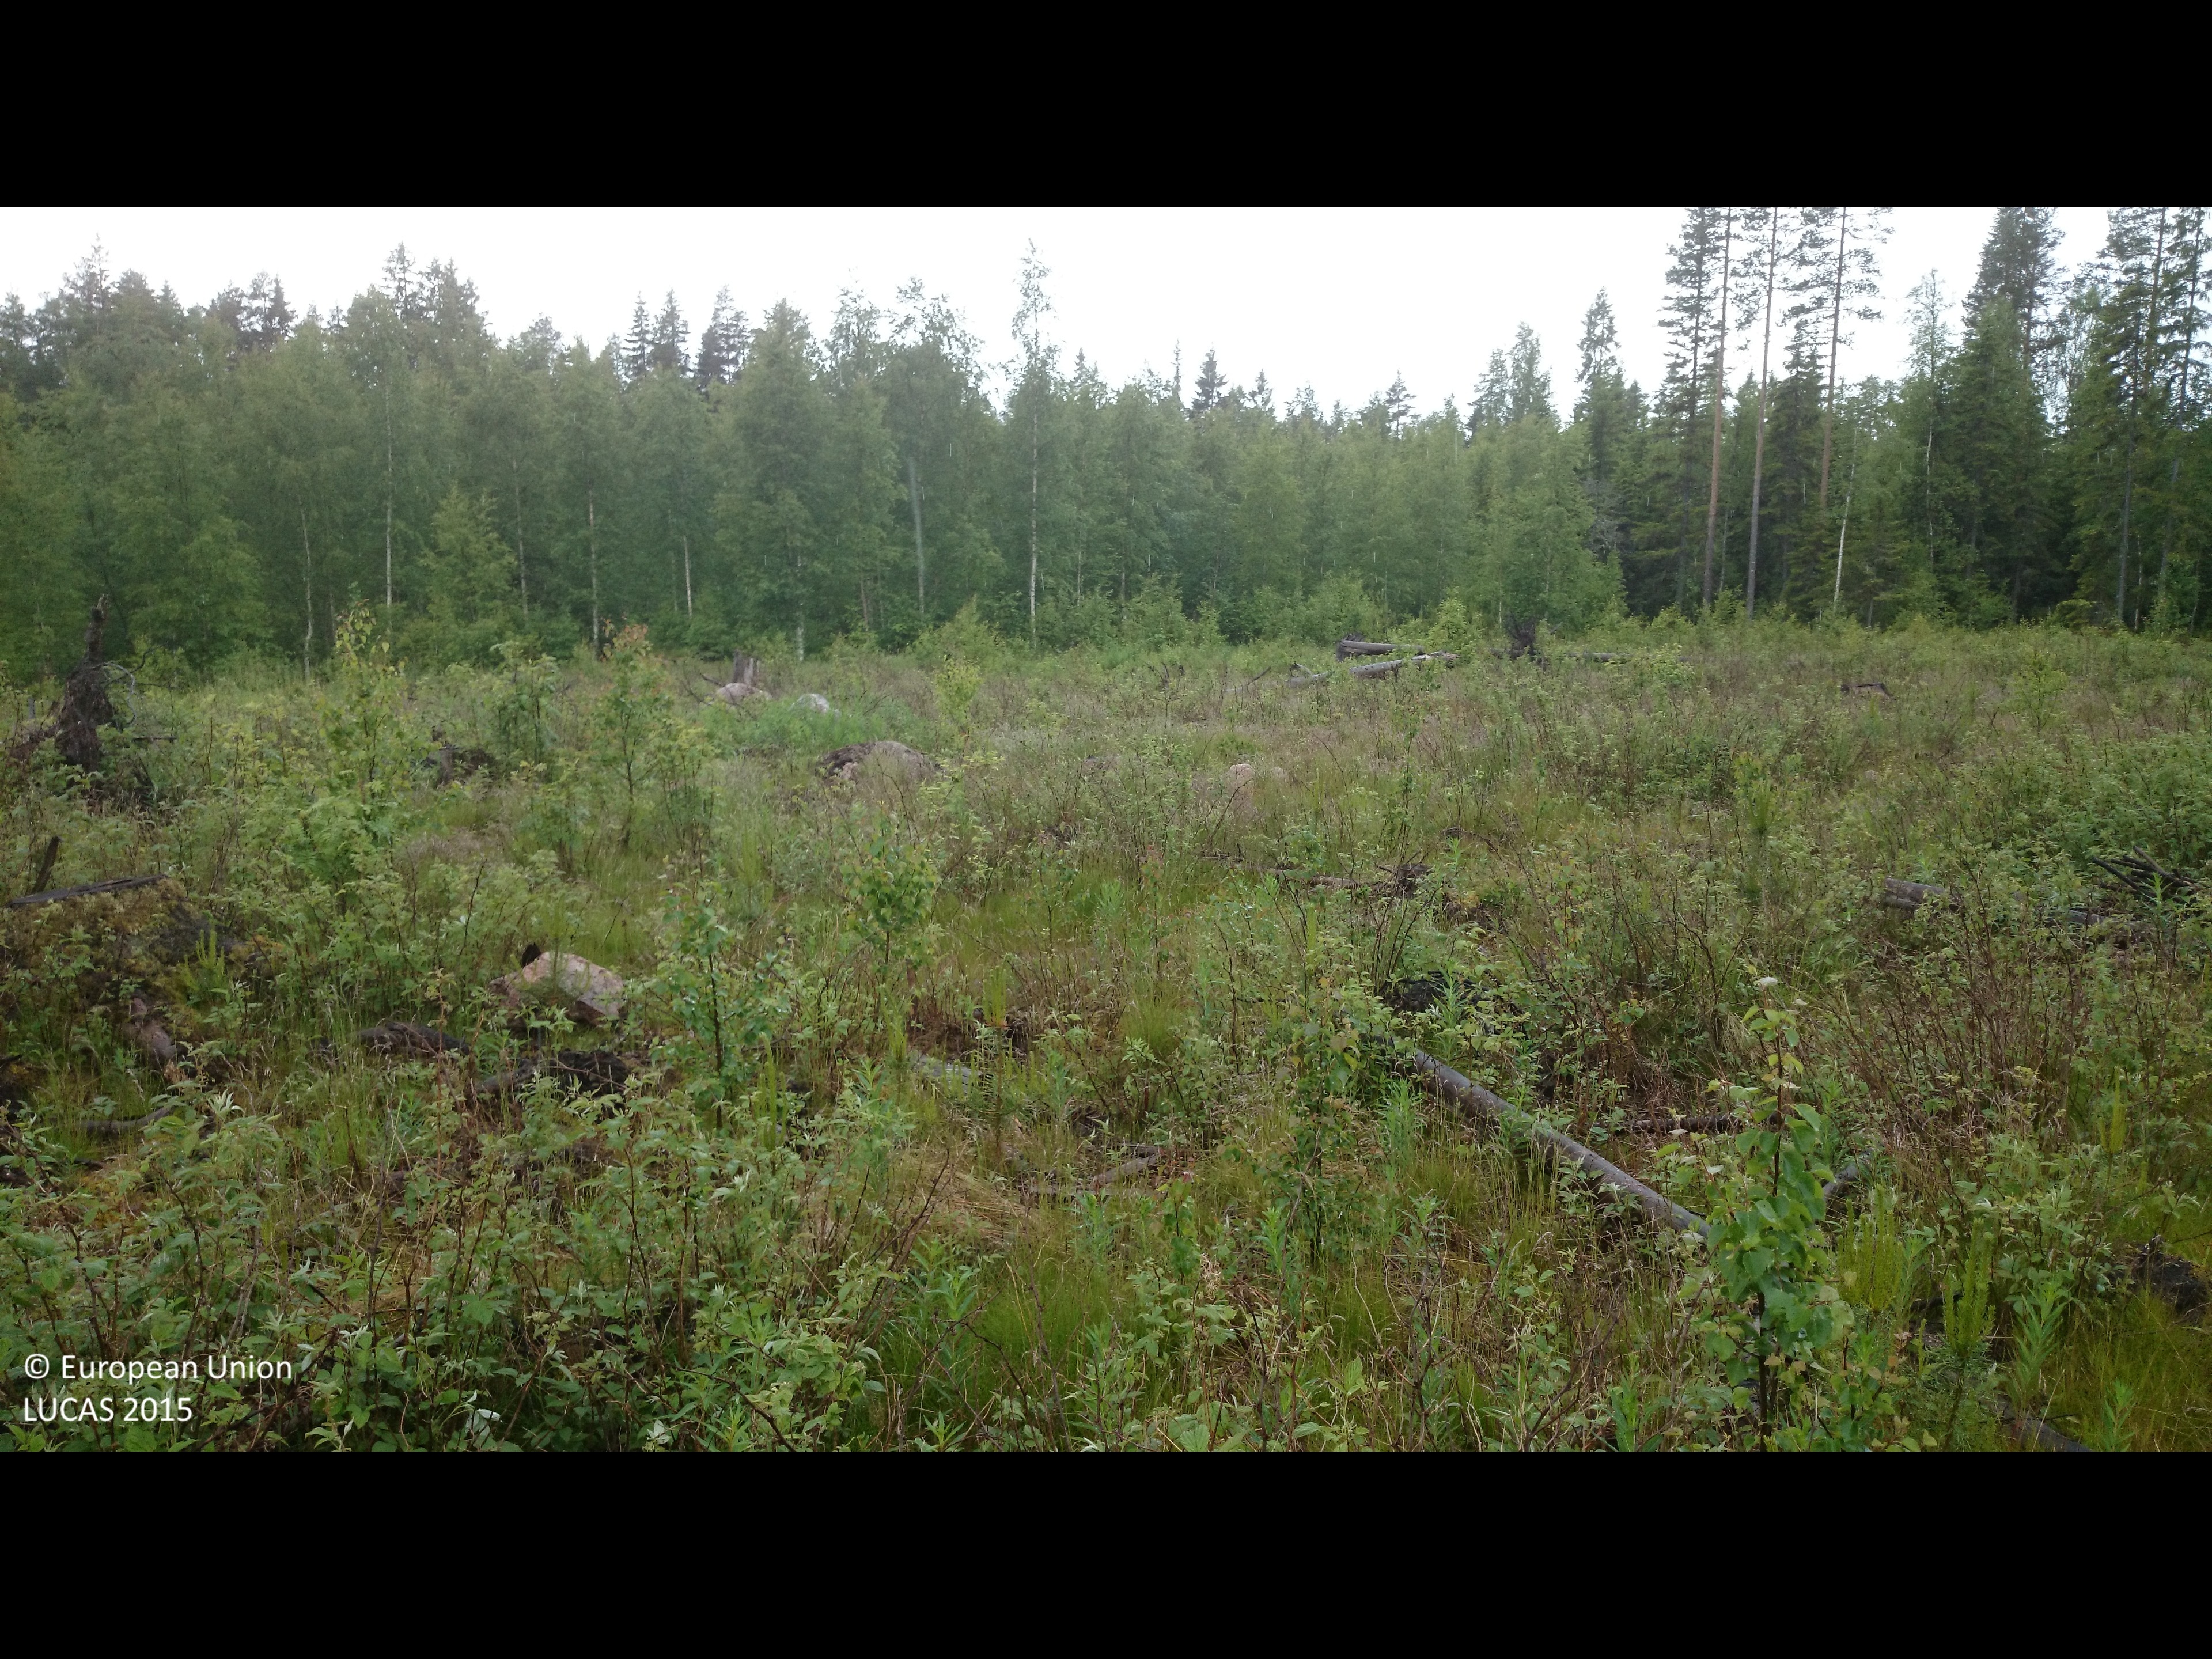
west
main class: Shrubland
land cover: Shrubland with sparse tree cover
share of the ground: 25 - 50 %
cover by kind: herbaceous plants 40 %, shrubs 30 %, lichens and mosses 25 %, coniferous forest trees 5 %
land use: Forestry
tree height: < 5 m
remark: Clear cut
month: June
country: SE
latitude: 61.9848
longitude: 16.8715
